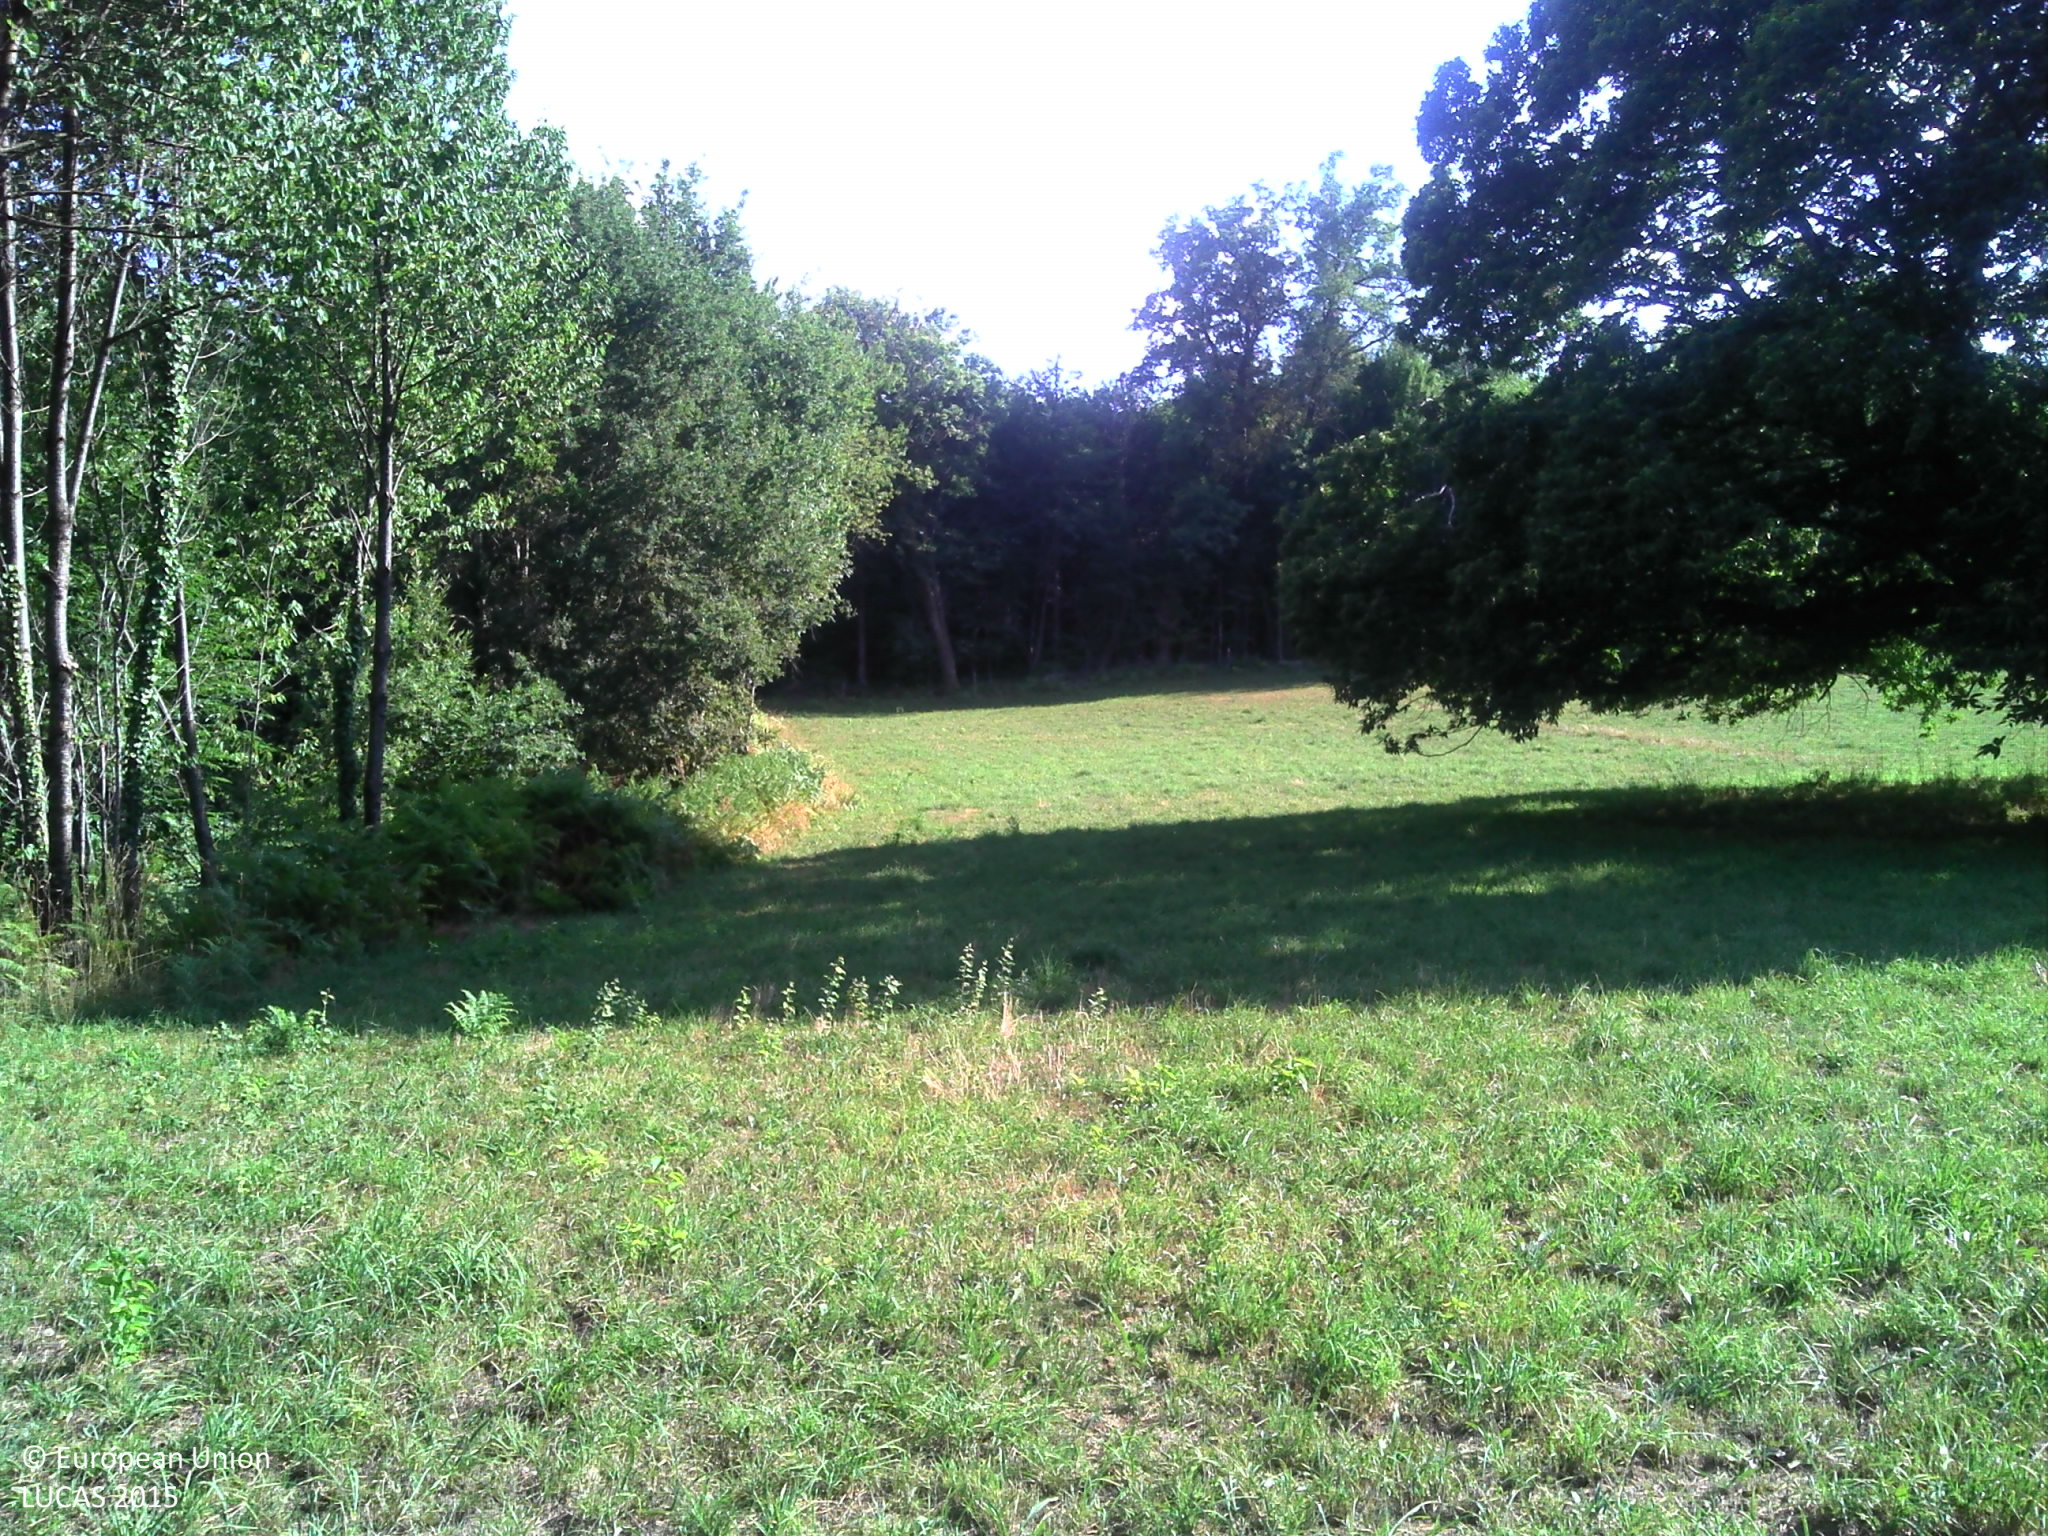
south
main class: Grassland
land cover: Grassland with sparse tree/shrub cover
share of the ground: > 75 %
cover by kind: herbaceous plants 85 %, shrubs 10 %, broadleaved forest trees 5 %
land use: Agriculture (excluding fallow land and kitchen gardens)
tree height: > 5 m
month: August
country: FR
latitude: 45.2497
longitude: 1.7012
